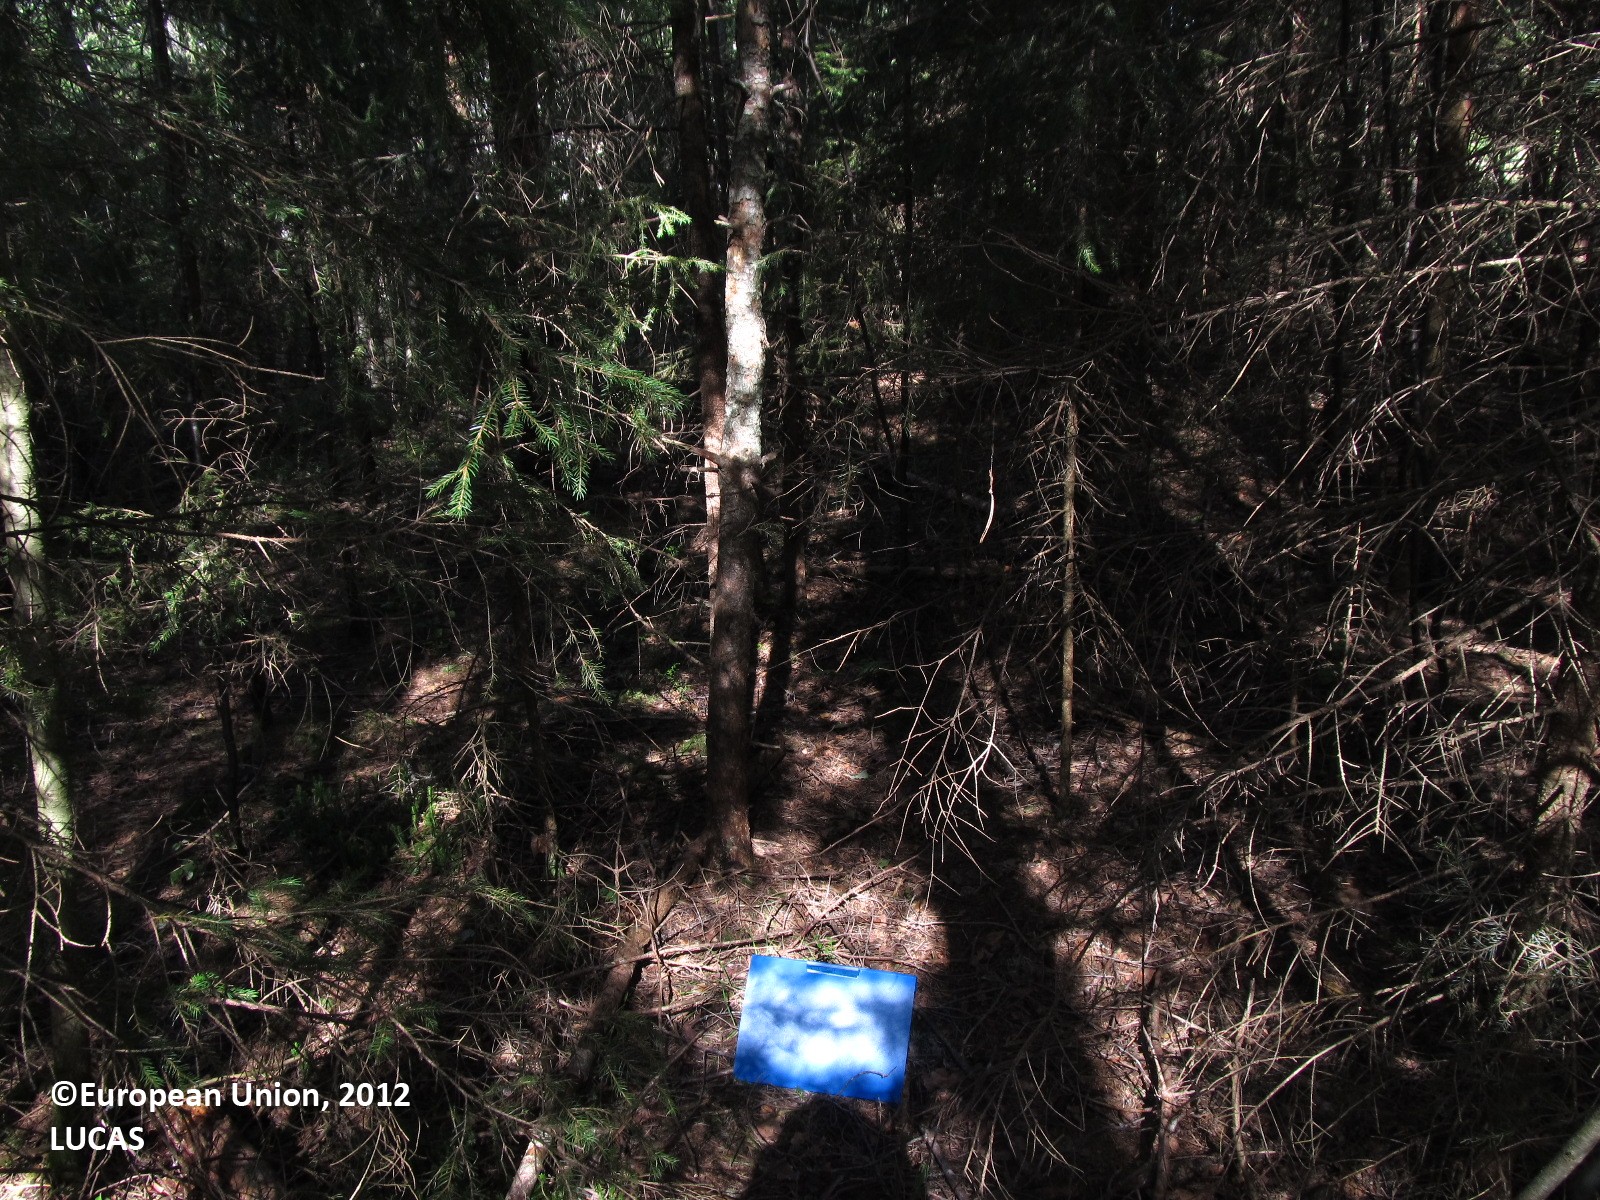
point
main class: Woodland
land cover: Spruce dominated coniferous woodland
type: boreal forest
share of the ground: 25 - 50 %
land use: Forestry
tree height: > 5 m
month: August
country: FI
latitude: 62.3274
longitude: 27.7210
